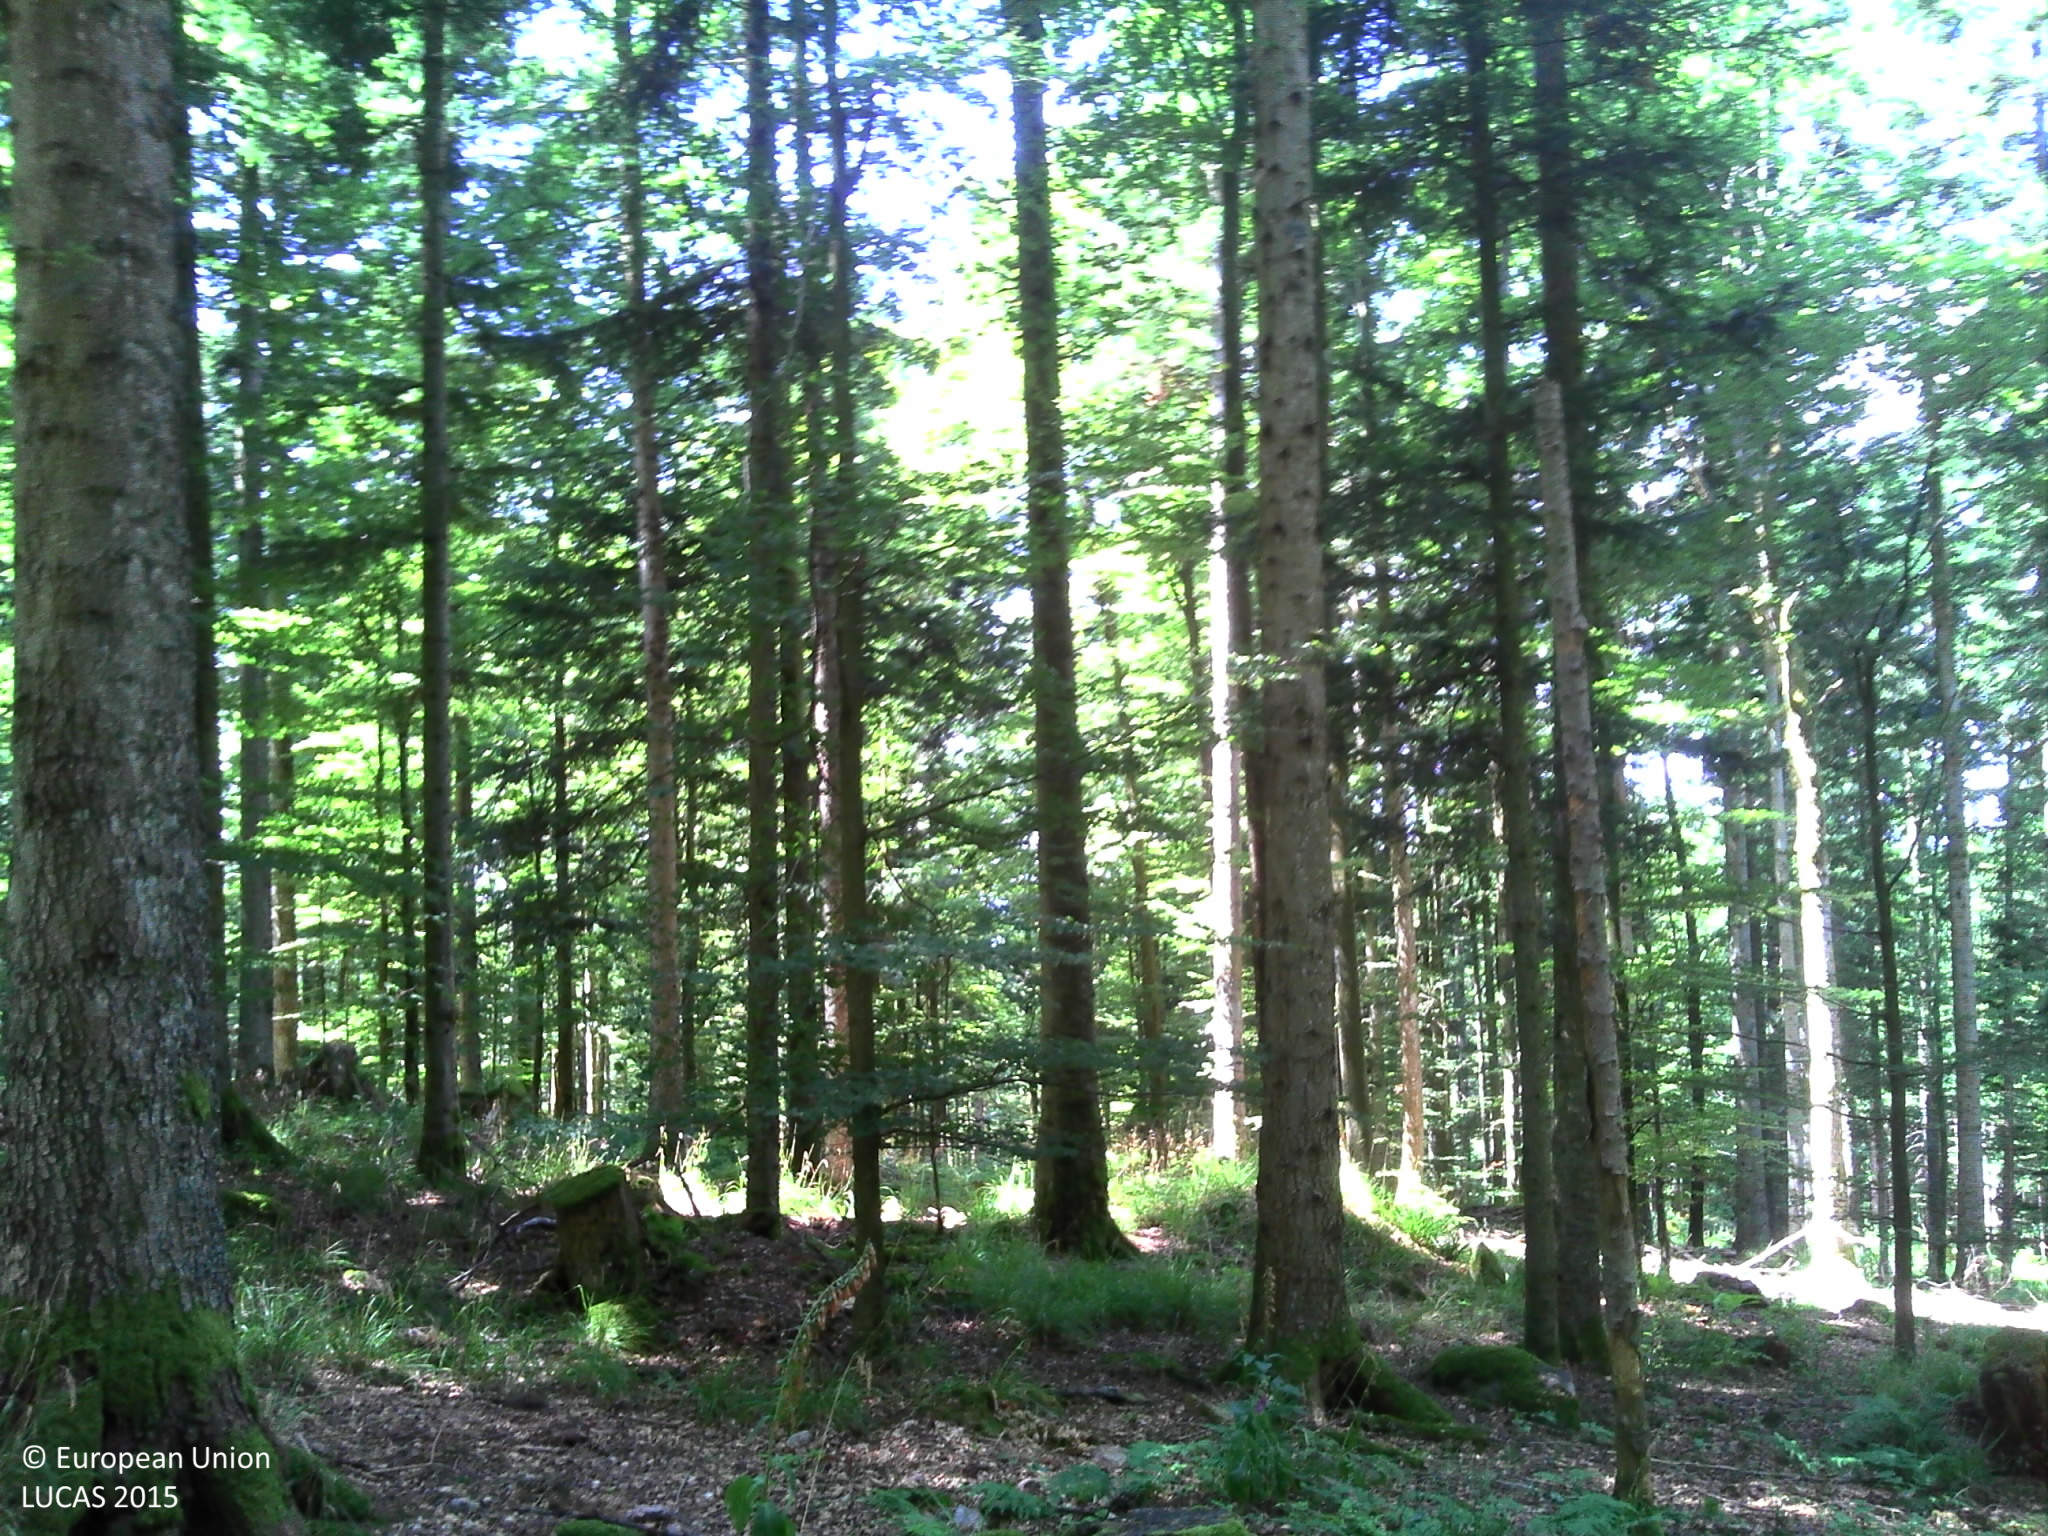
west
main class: Woodland
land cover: Spruce dominated mixed woodland
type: hemiboreal forest and nemoral coniferous forest and mixed broadleaved-coniferous forest
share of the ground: > 75 %
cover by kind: broadleaved forest trees 50 %, coniferous forest trees 45 %, herbaceous plants 5 %
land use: Forestry
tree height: > 5 m
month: July
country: FR
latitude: 48.4601
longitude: 7.2827
